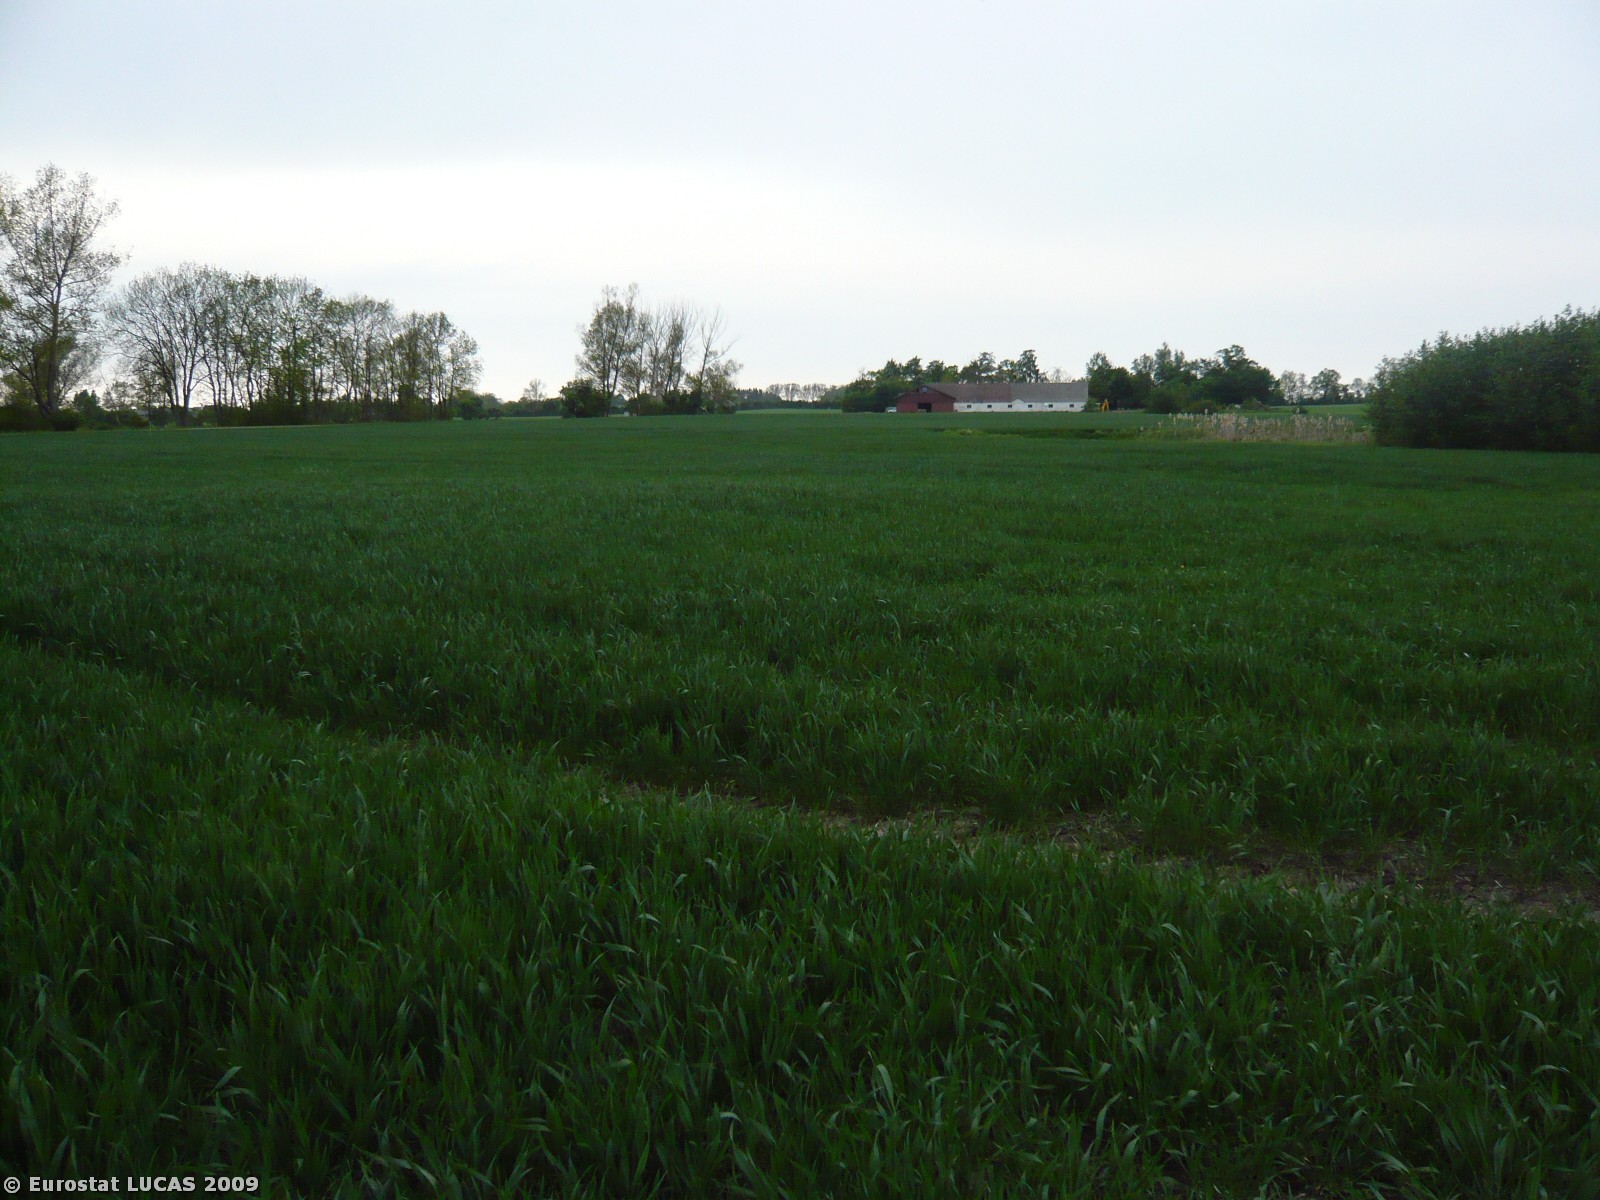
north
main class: Cropland
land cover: Common wheat
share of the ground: > 75 %
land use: Agriculture (excluding fallow land and kitchen gardens)
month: May
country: DK
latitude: 55.3990
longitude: 12.0038
